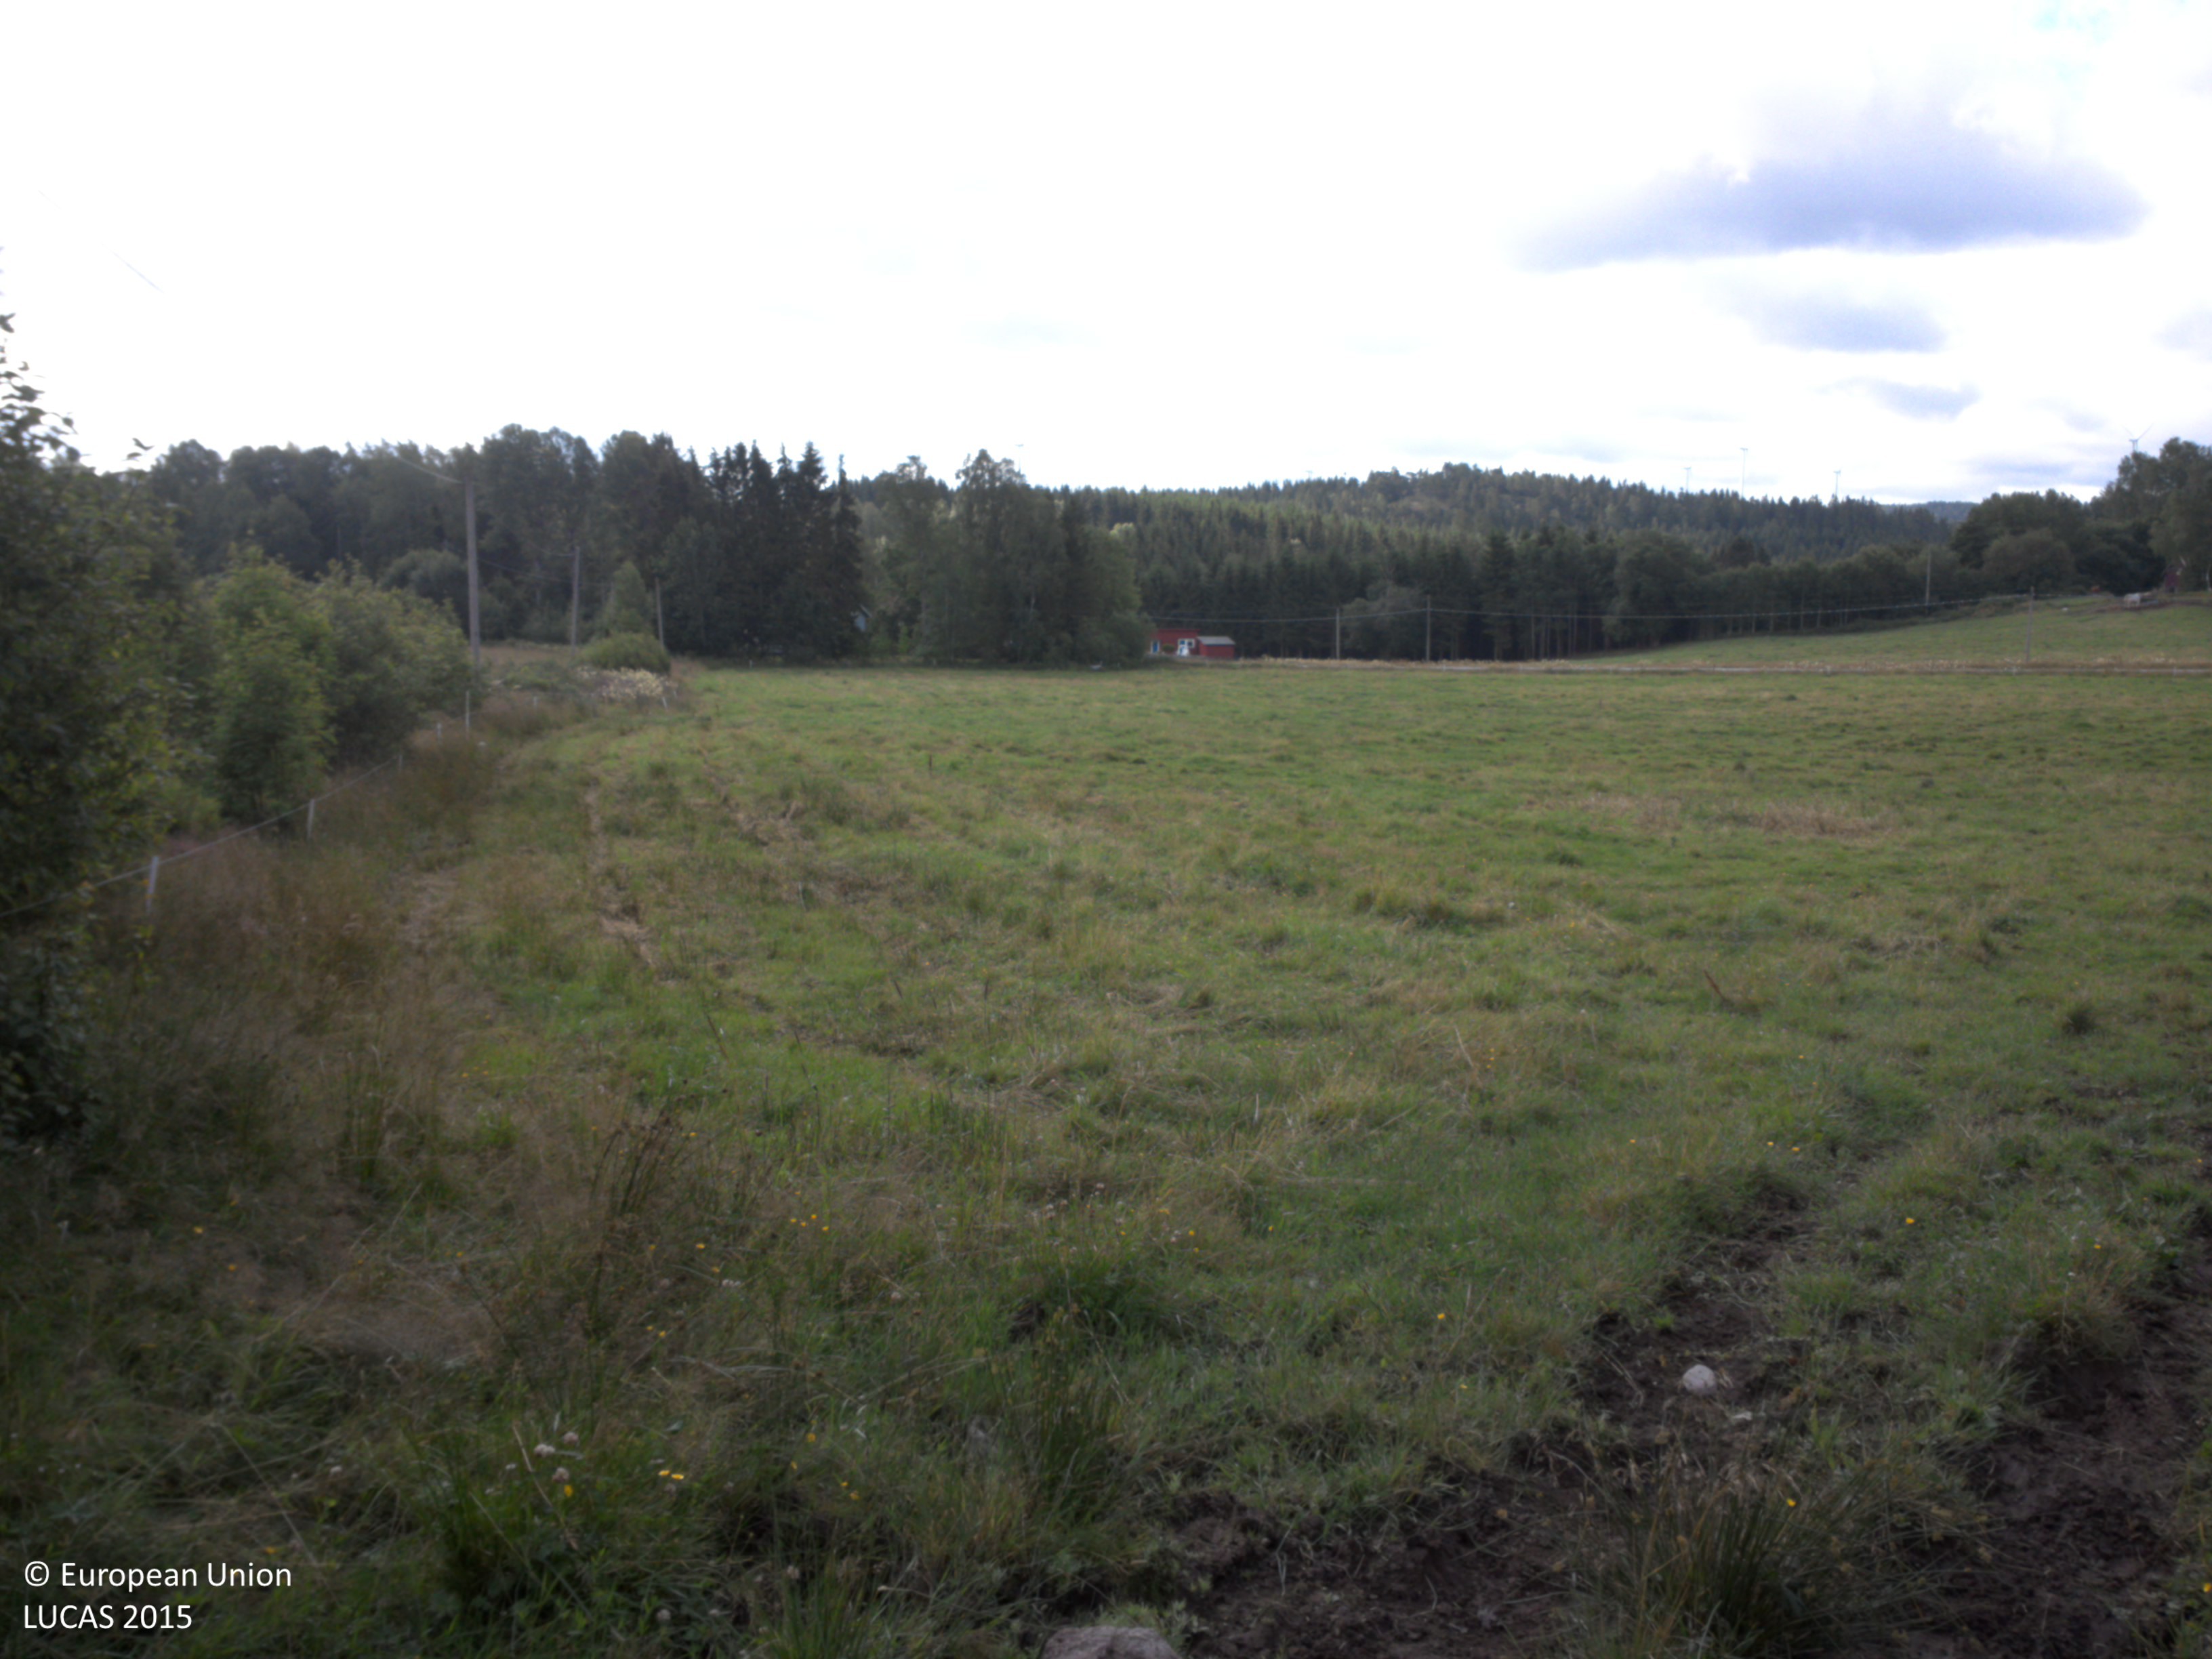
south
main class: Grassland
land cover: Grassland without tree/shrub cover
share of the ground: > 75 %
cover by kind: herbaceous plants 80 %, unconsolidated bare surface 20 %
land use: Agriculture (excluding fallow land and kitchen gardens)
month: July
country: SE
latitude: 58.6392
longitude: 11.8050
